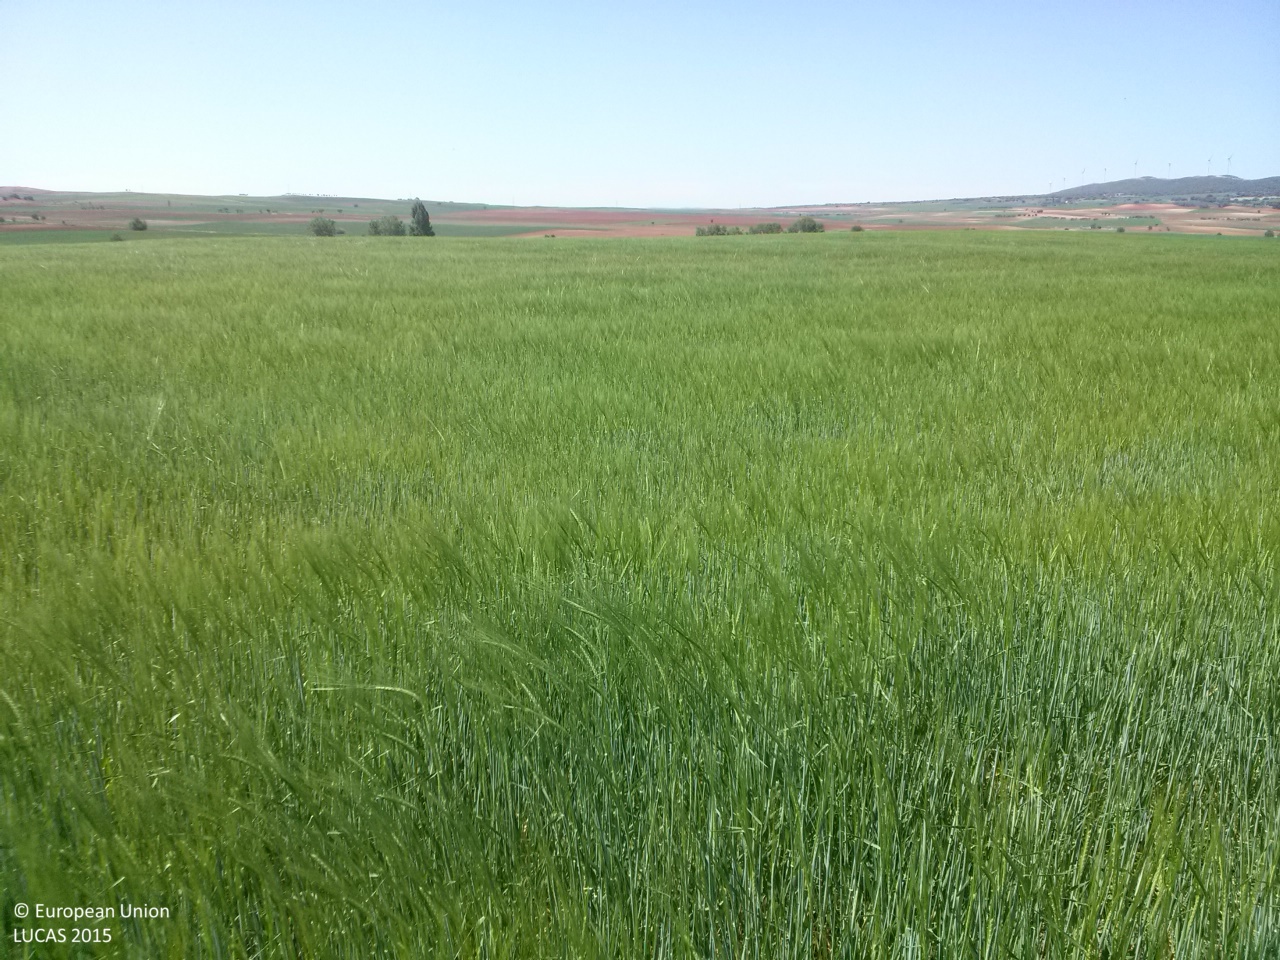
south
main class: Cropland
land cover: Barley
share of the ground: > 75 %
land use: Agriculture (excluding fallow land and kitchen gardens)
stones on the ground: 10 - 25 %
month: May
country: ES
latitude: 39.7933
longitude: -2.7829
